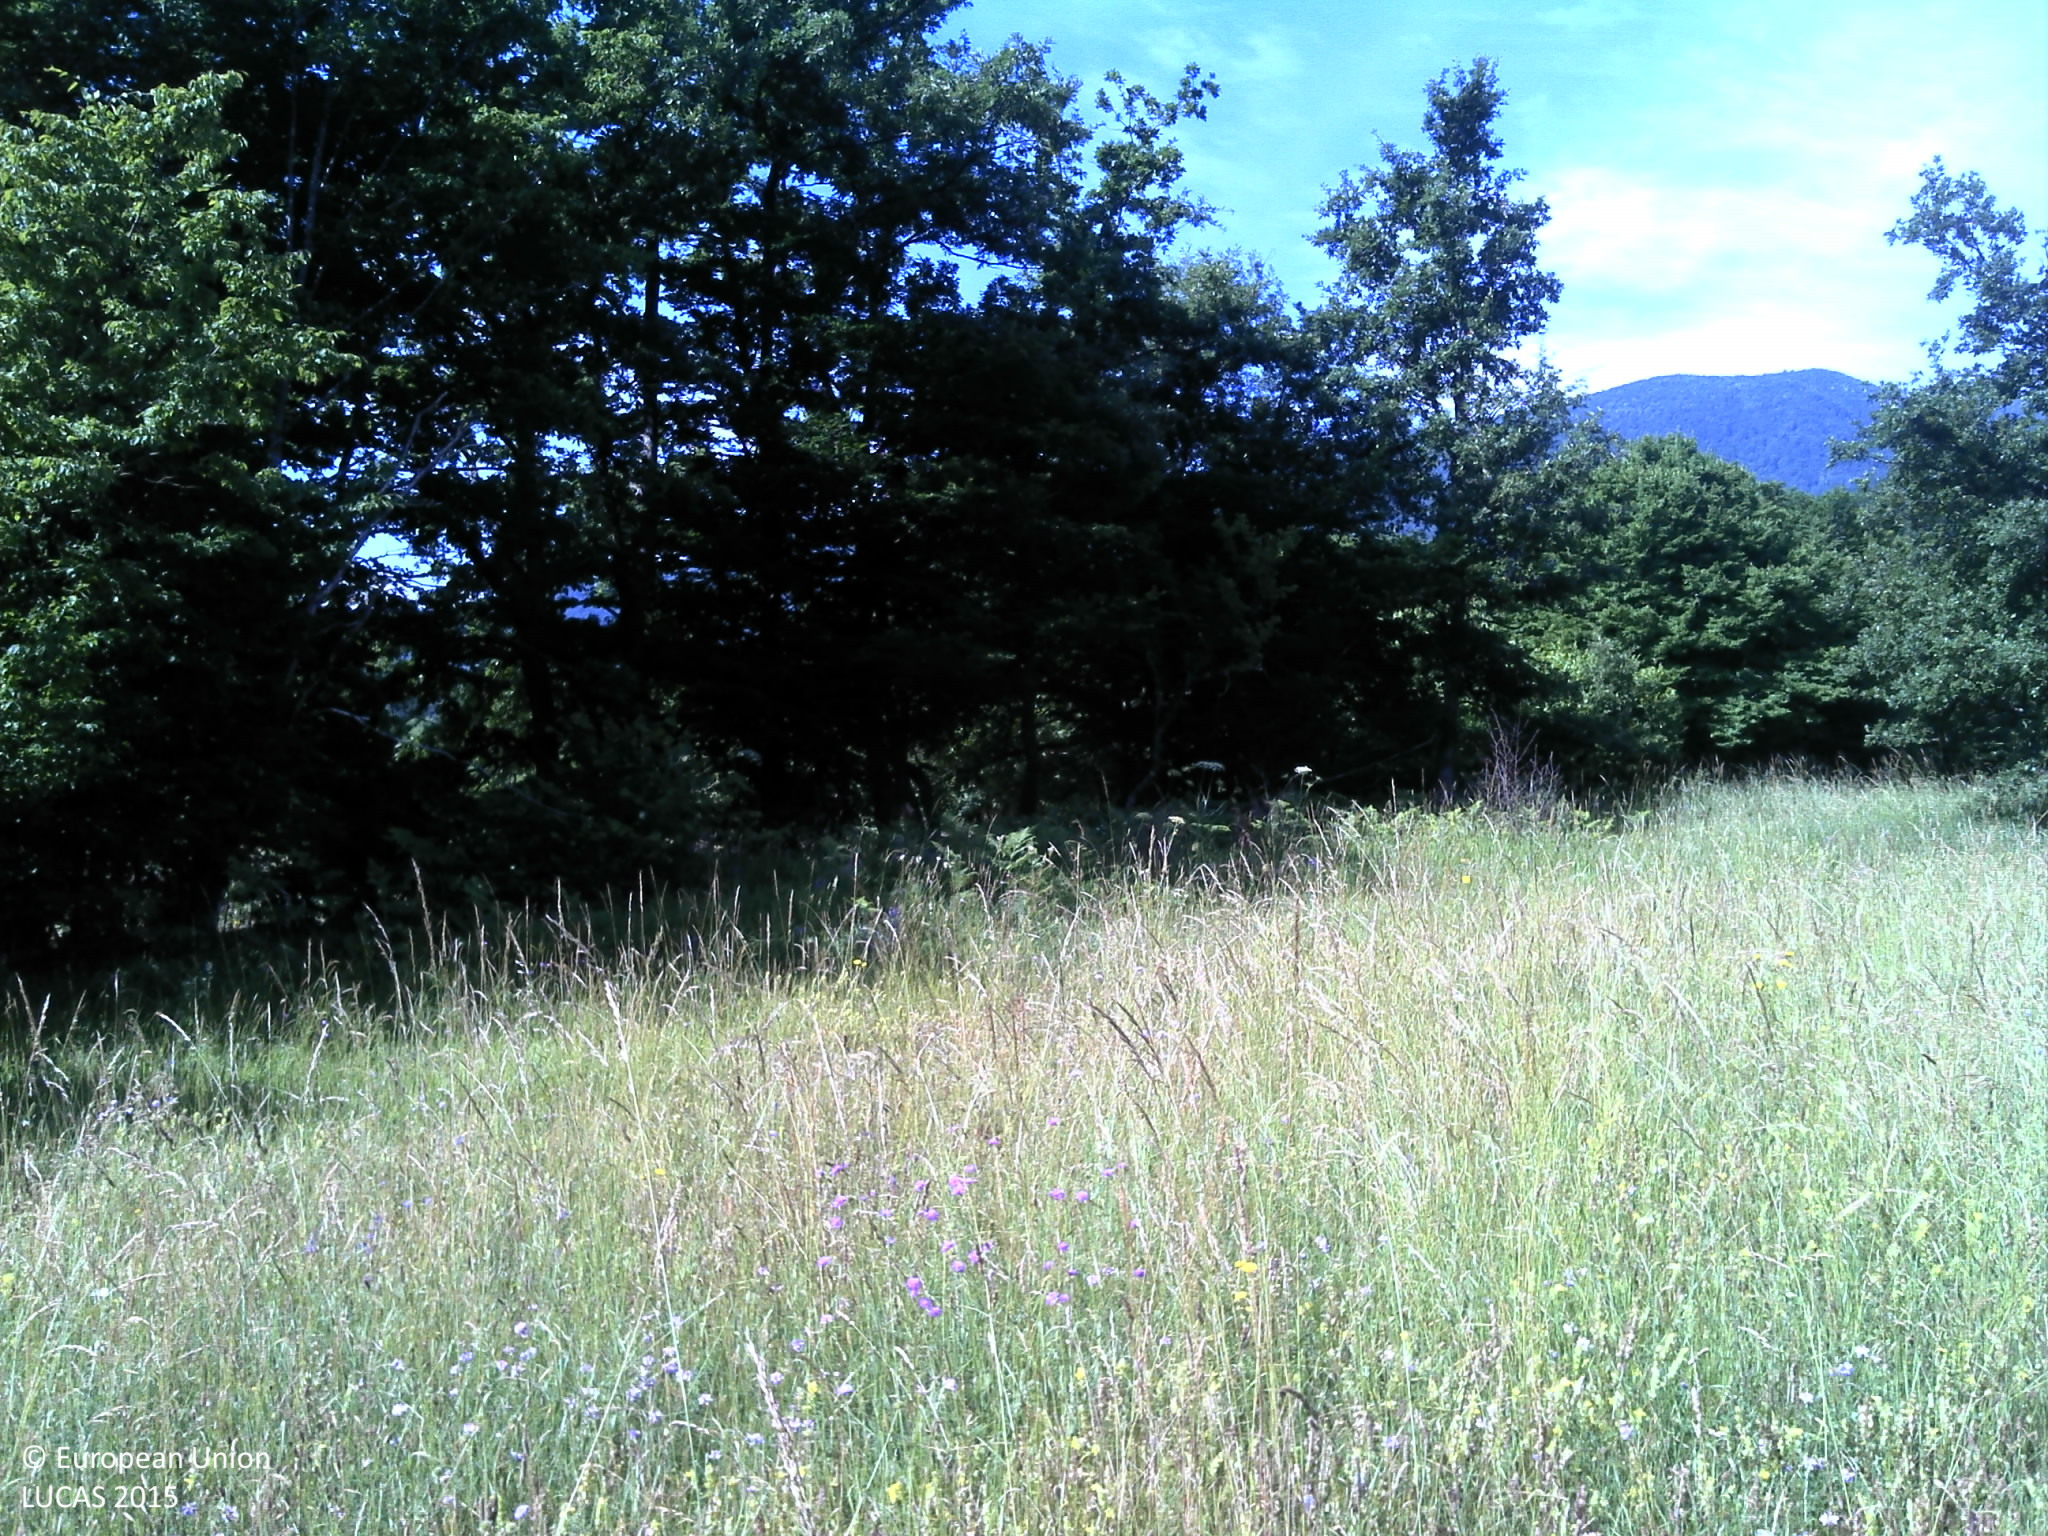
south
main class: Grassland
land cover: Grassland without tree/shrub cover
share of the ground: > 75 %
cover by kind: herbaceous plants 100 %
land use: Semi-natural and natural areas not in use
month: June
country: HR
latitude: 44.5789
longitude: 15.9258
